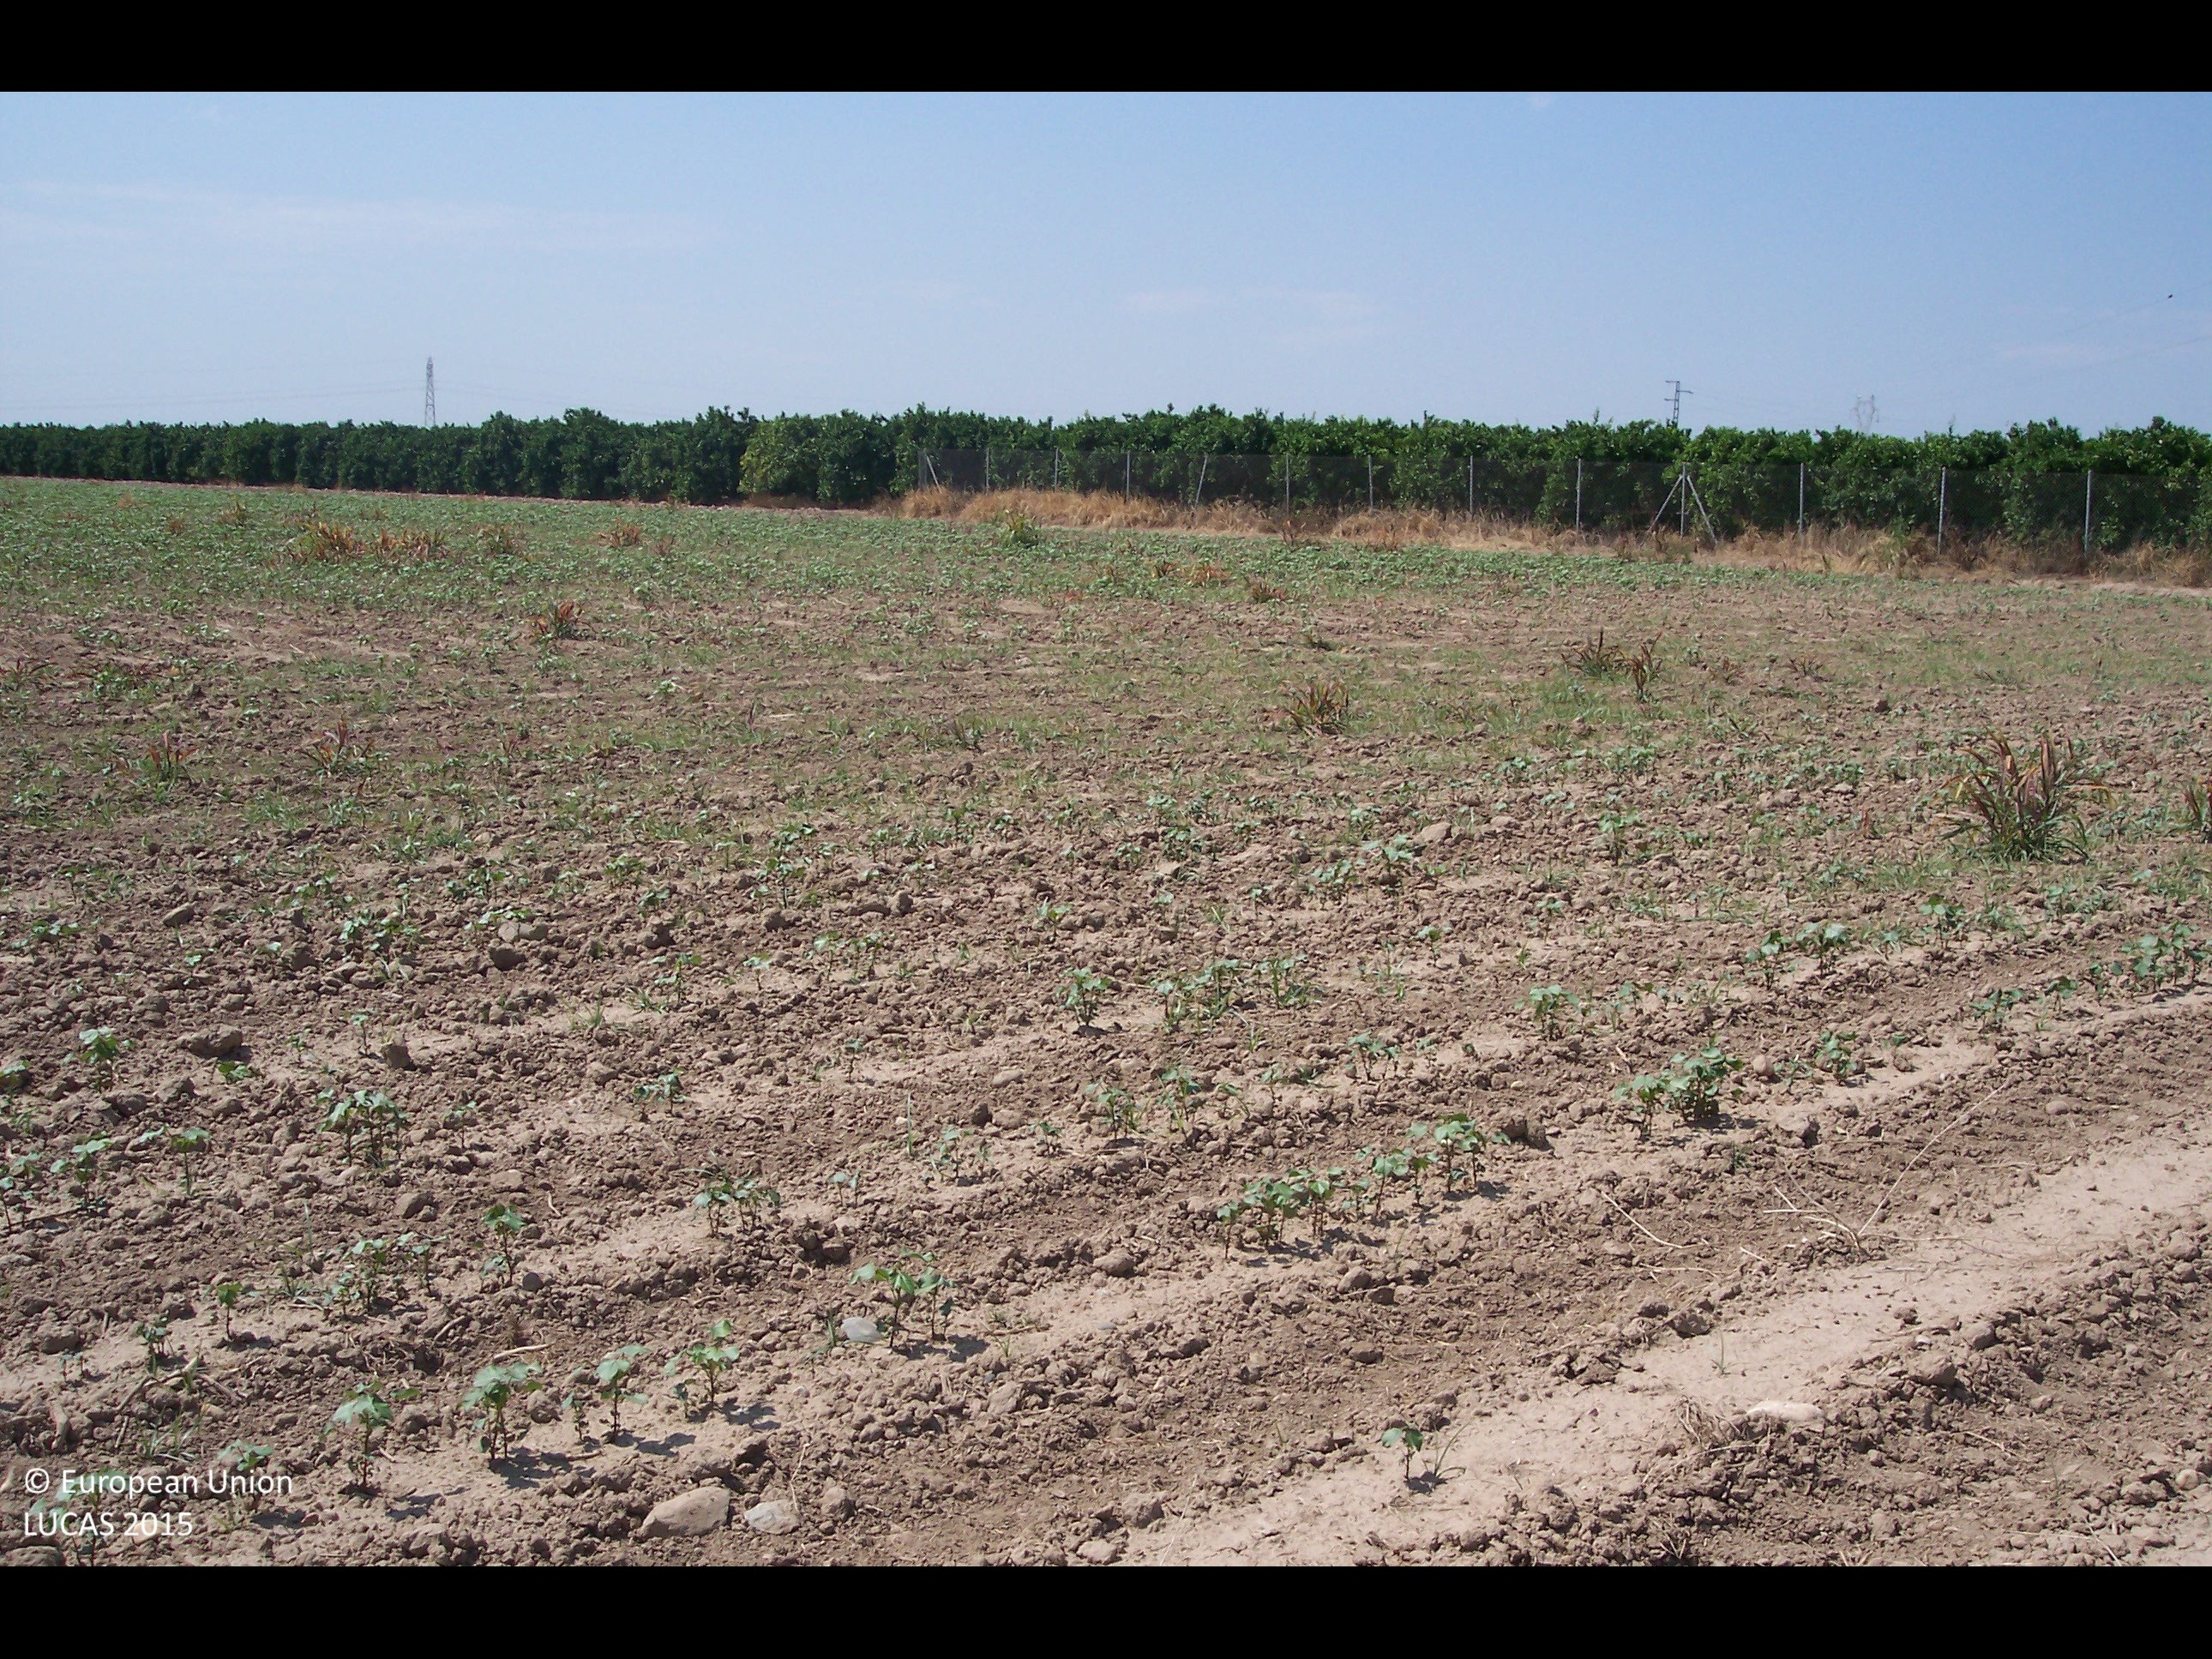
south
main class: Cropland
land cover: Cotton
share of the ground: < 10 %
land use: Agriculture (excluding fallow land and kitchen gardens)
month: May
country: ES
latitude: 37.5389
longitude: -5.9264
